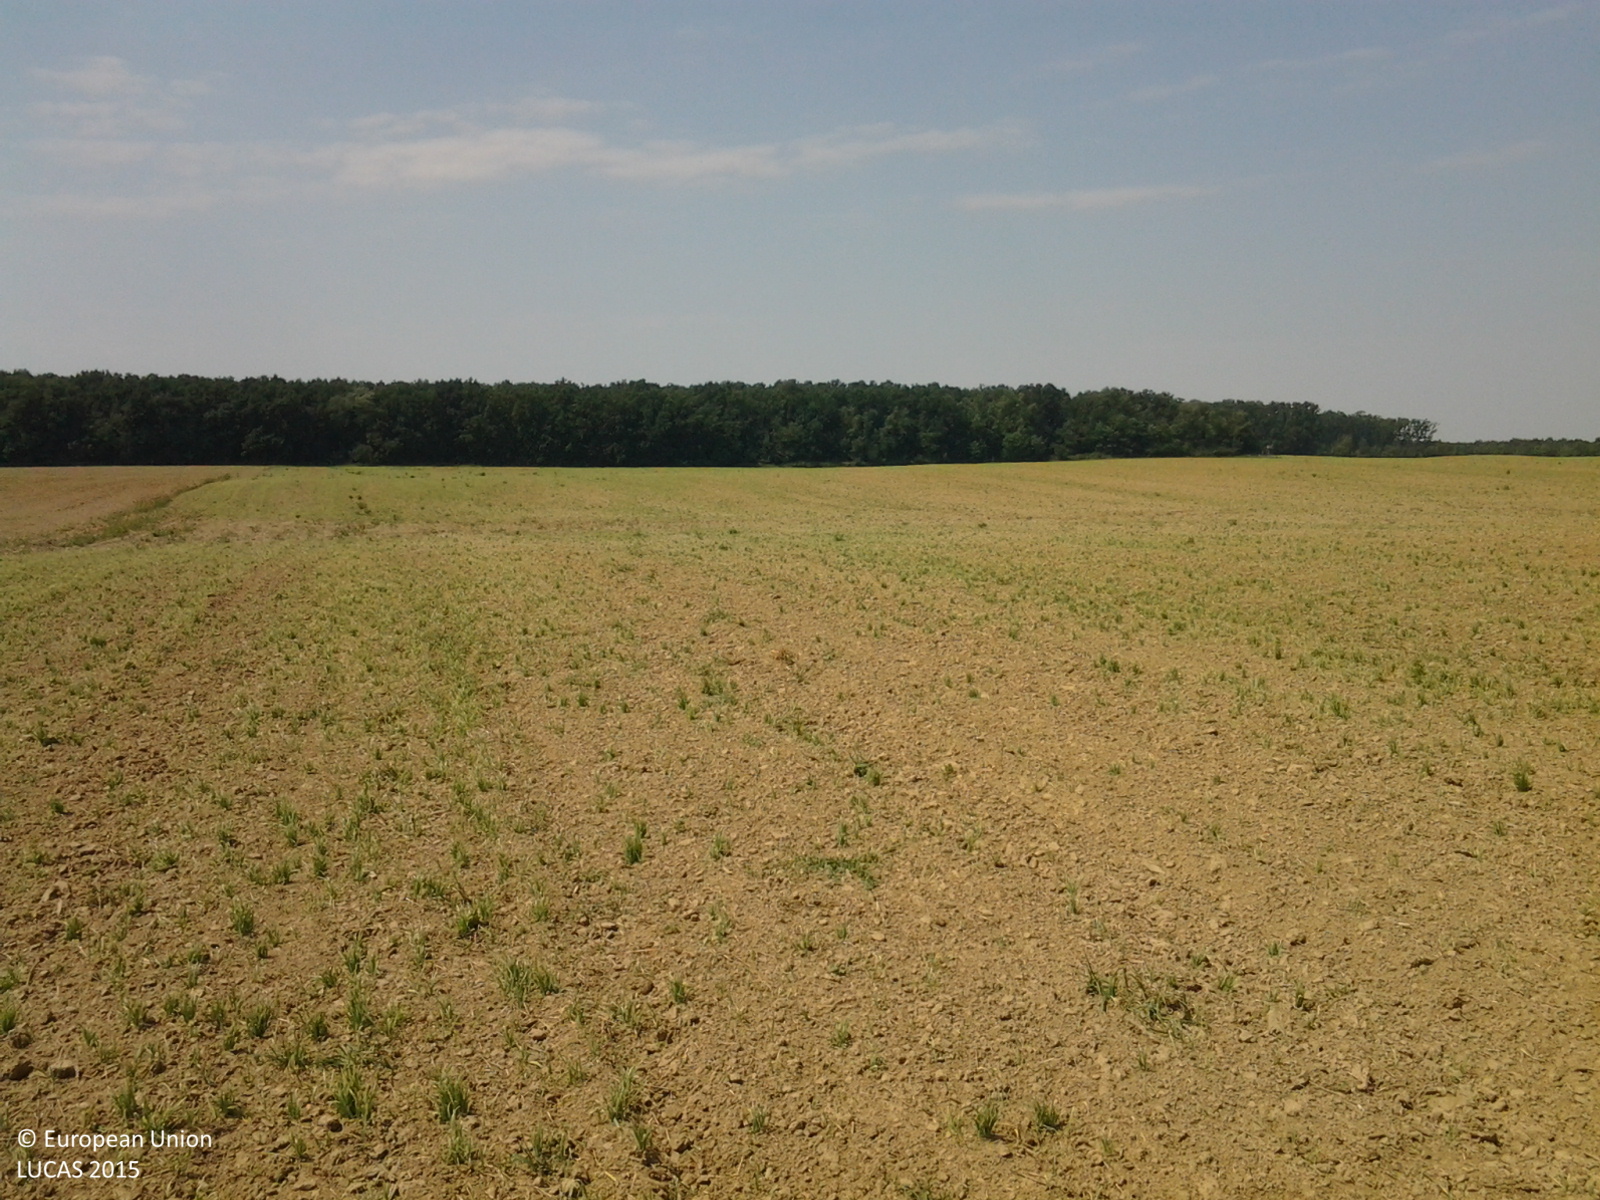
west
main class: Cropland
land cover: Common wheat
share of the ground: < 10 %
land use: Agriculture (excluding fallow land and kitchen gardens)
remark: Harvested field
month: August
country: HU
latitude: 46.1384
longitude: 17.2908
